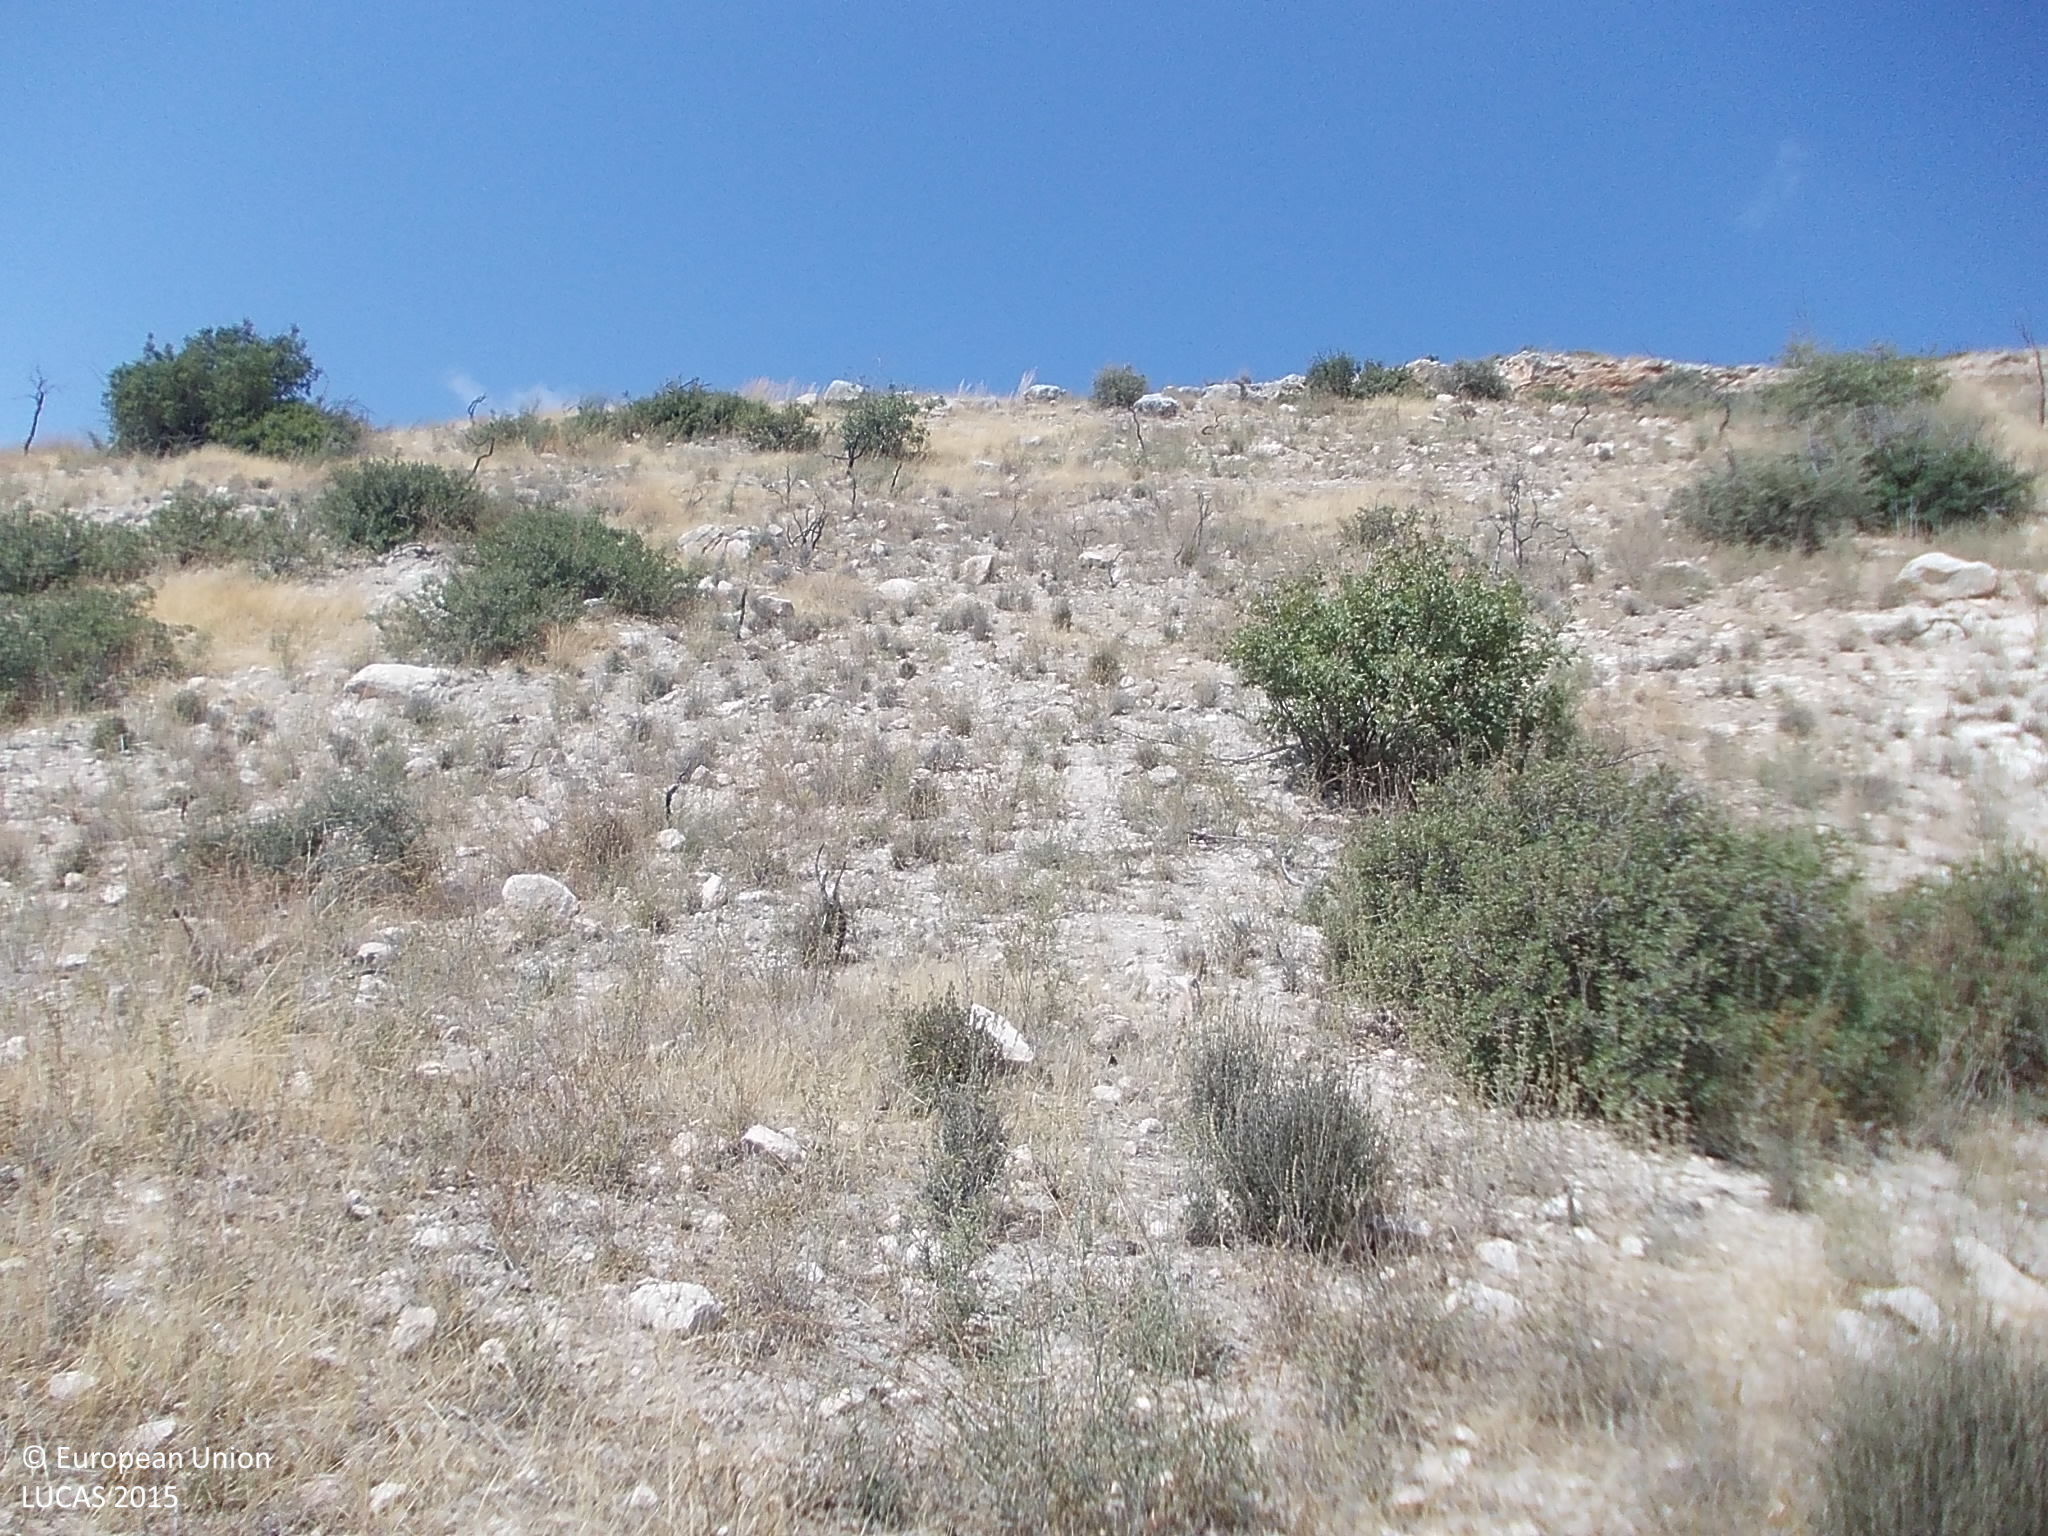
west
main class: Shrubland
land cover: Shrubland without tree cover
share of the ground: 25 - 50 %
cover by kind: shrubs 45 %, herbaceous plants 30 %, unconsolidated bare surface 20 %, consolidated bare surface 5 %
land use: Semi-natural and natural areas not in use
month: September
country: CY
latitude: 34.7118
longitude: 32.8812
